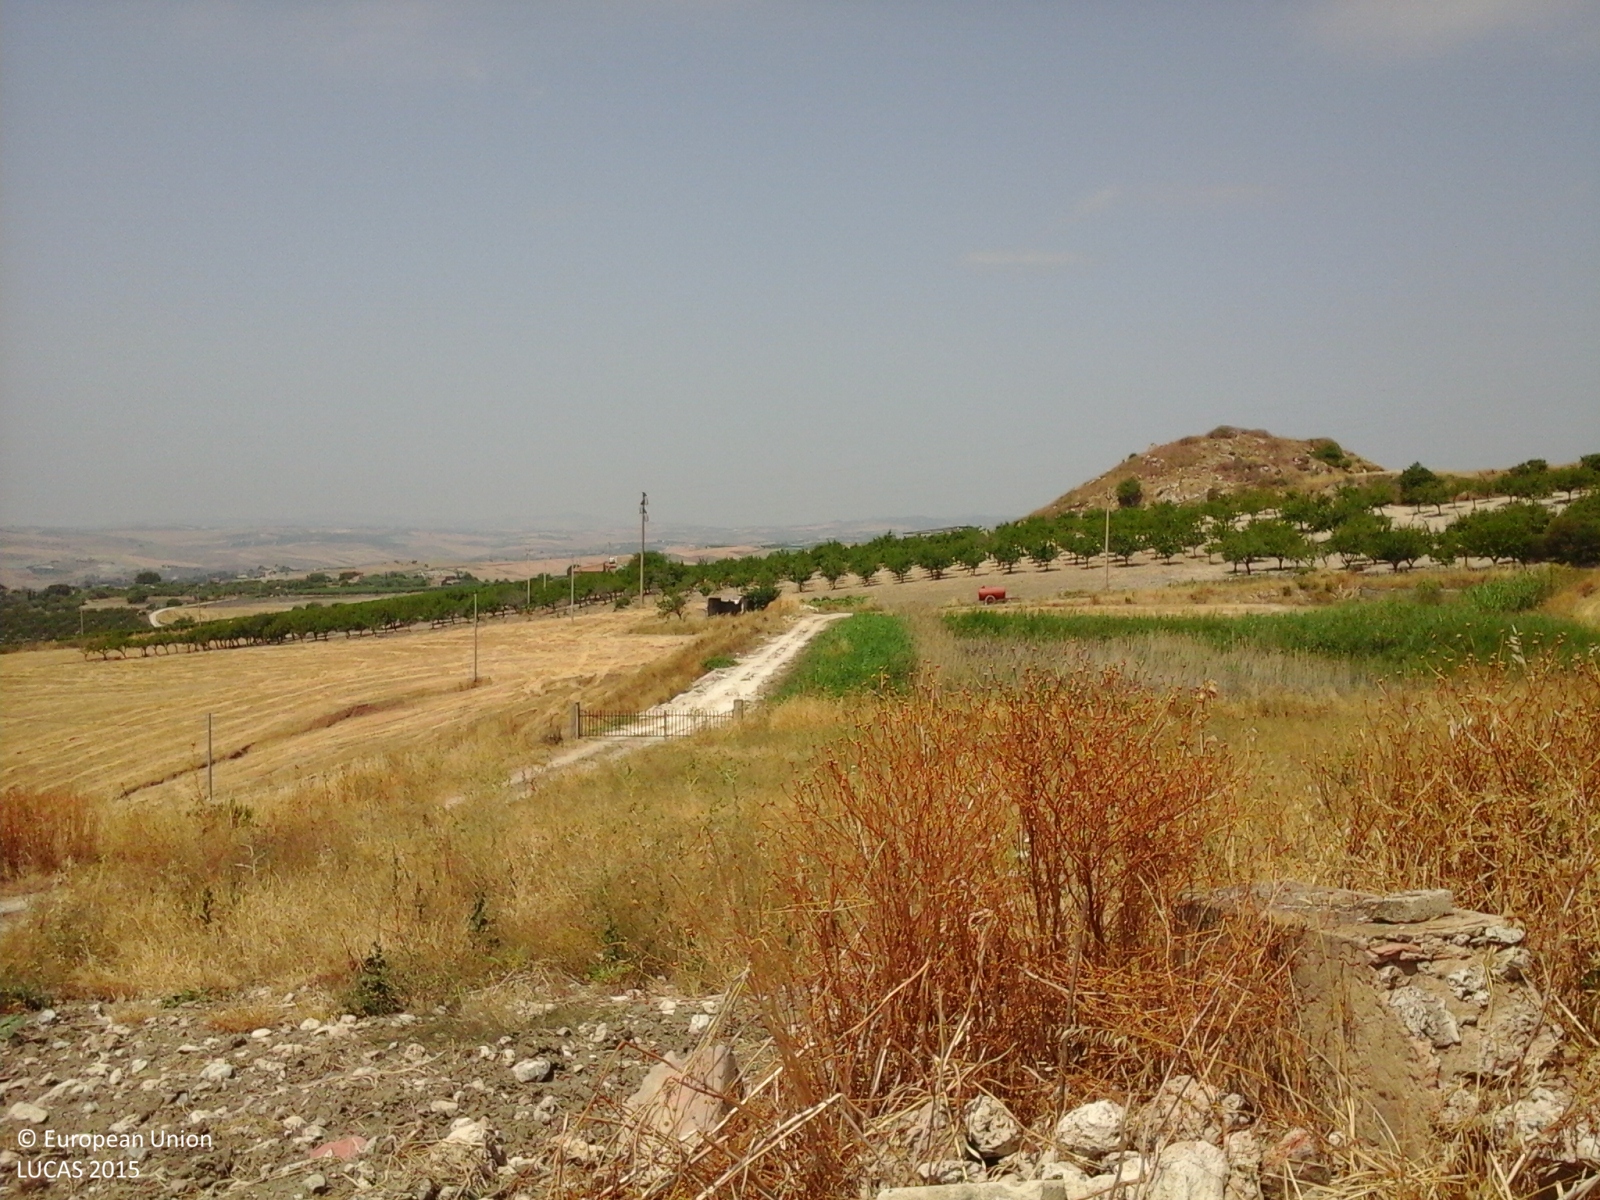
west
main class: Cropland
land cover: Arable land (only in case pi)
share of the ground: > 75 %
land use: Agriculture (excluding fallow land and kitchen gardens)
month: July
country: IT
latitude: 37.3544
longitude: 13.9998
